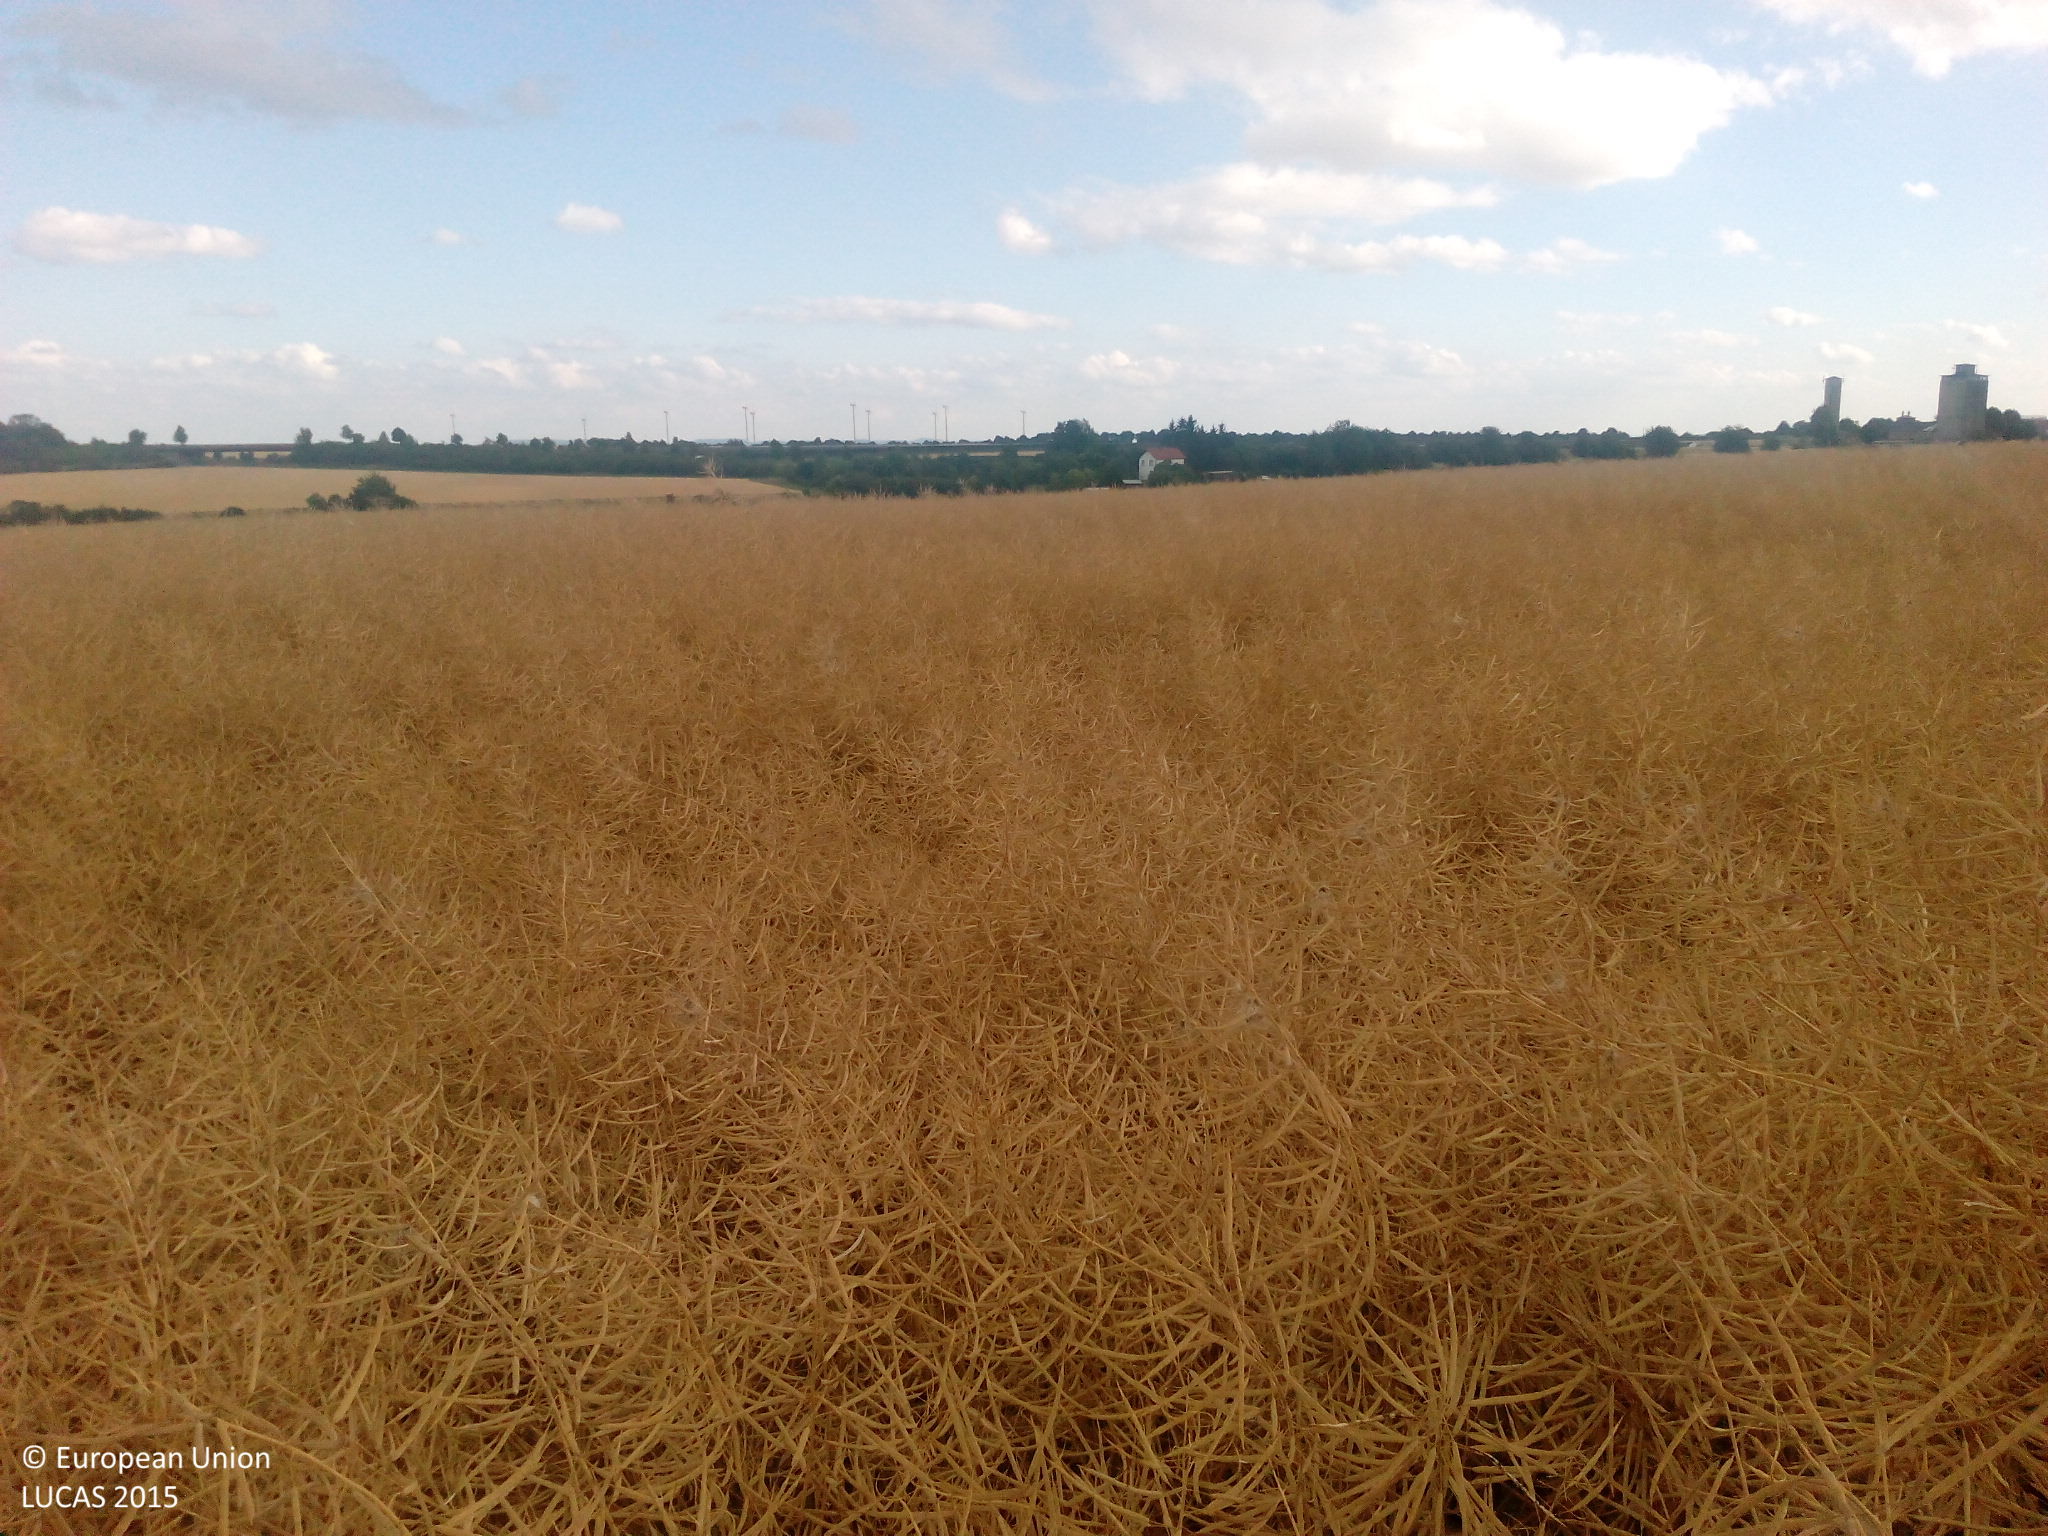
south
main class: Cropland
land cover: Rape and turnip rape
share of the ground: > 75 %
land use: Agriculture (excluding fallow land and kitchen gardens)
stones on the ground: < 10 %
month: July
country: DE
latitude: 49.6998
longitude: 8.0455
